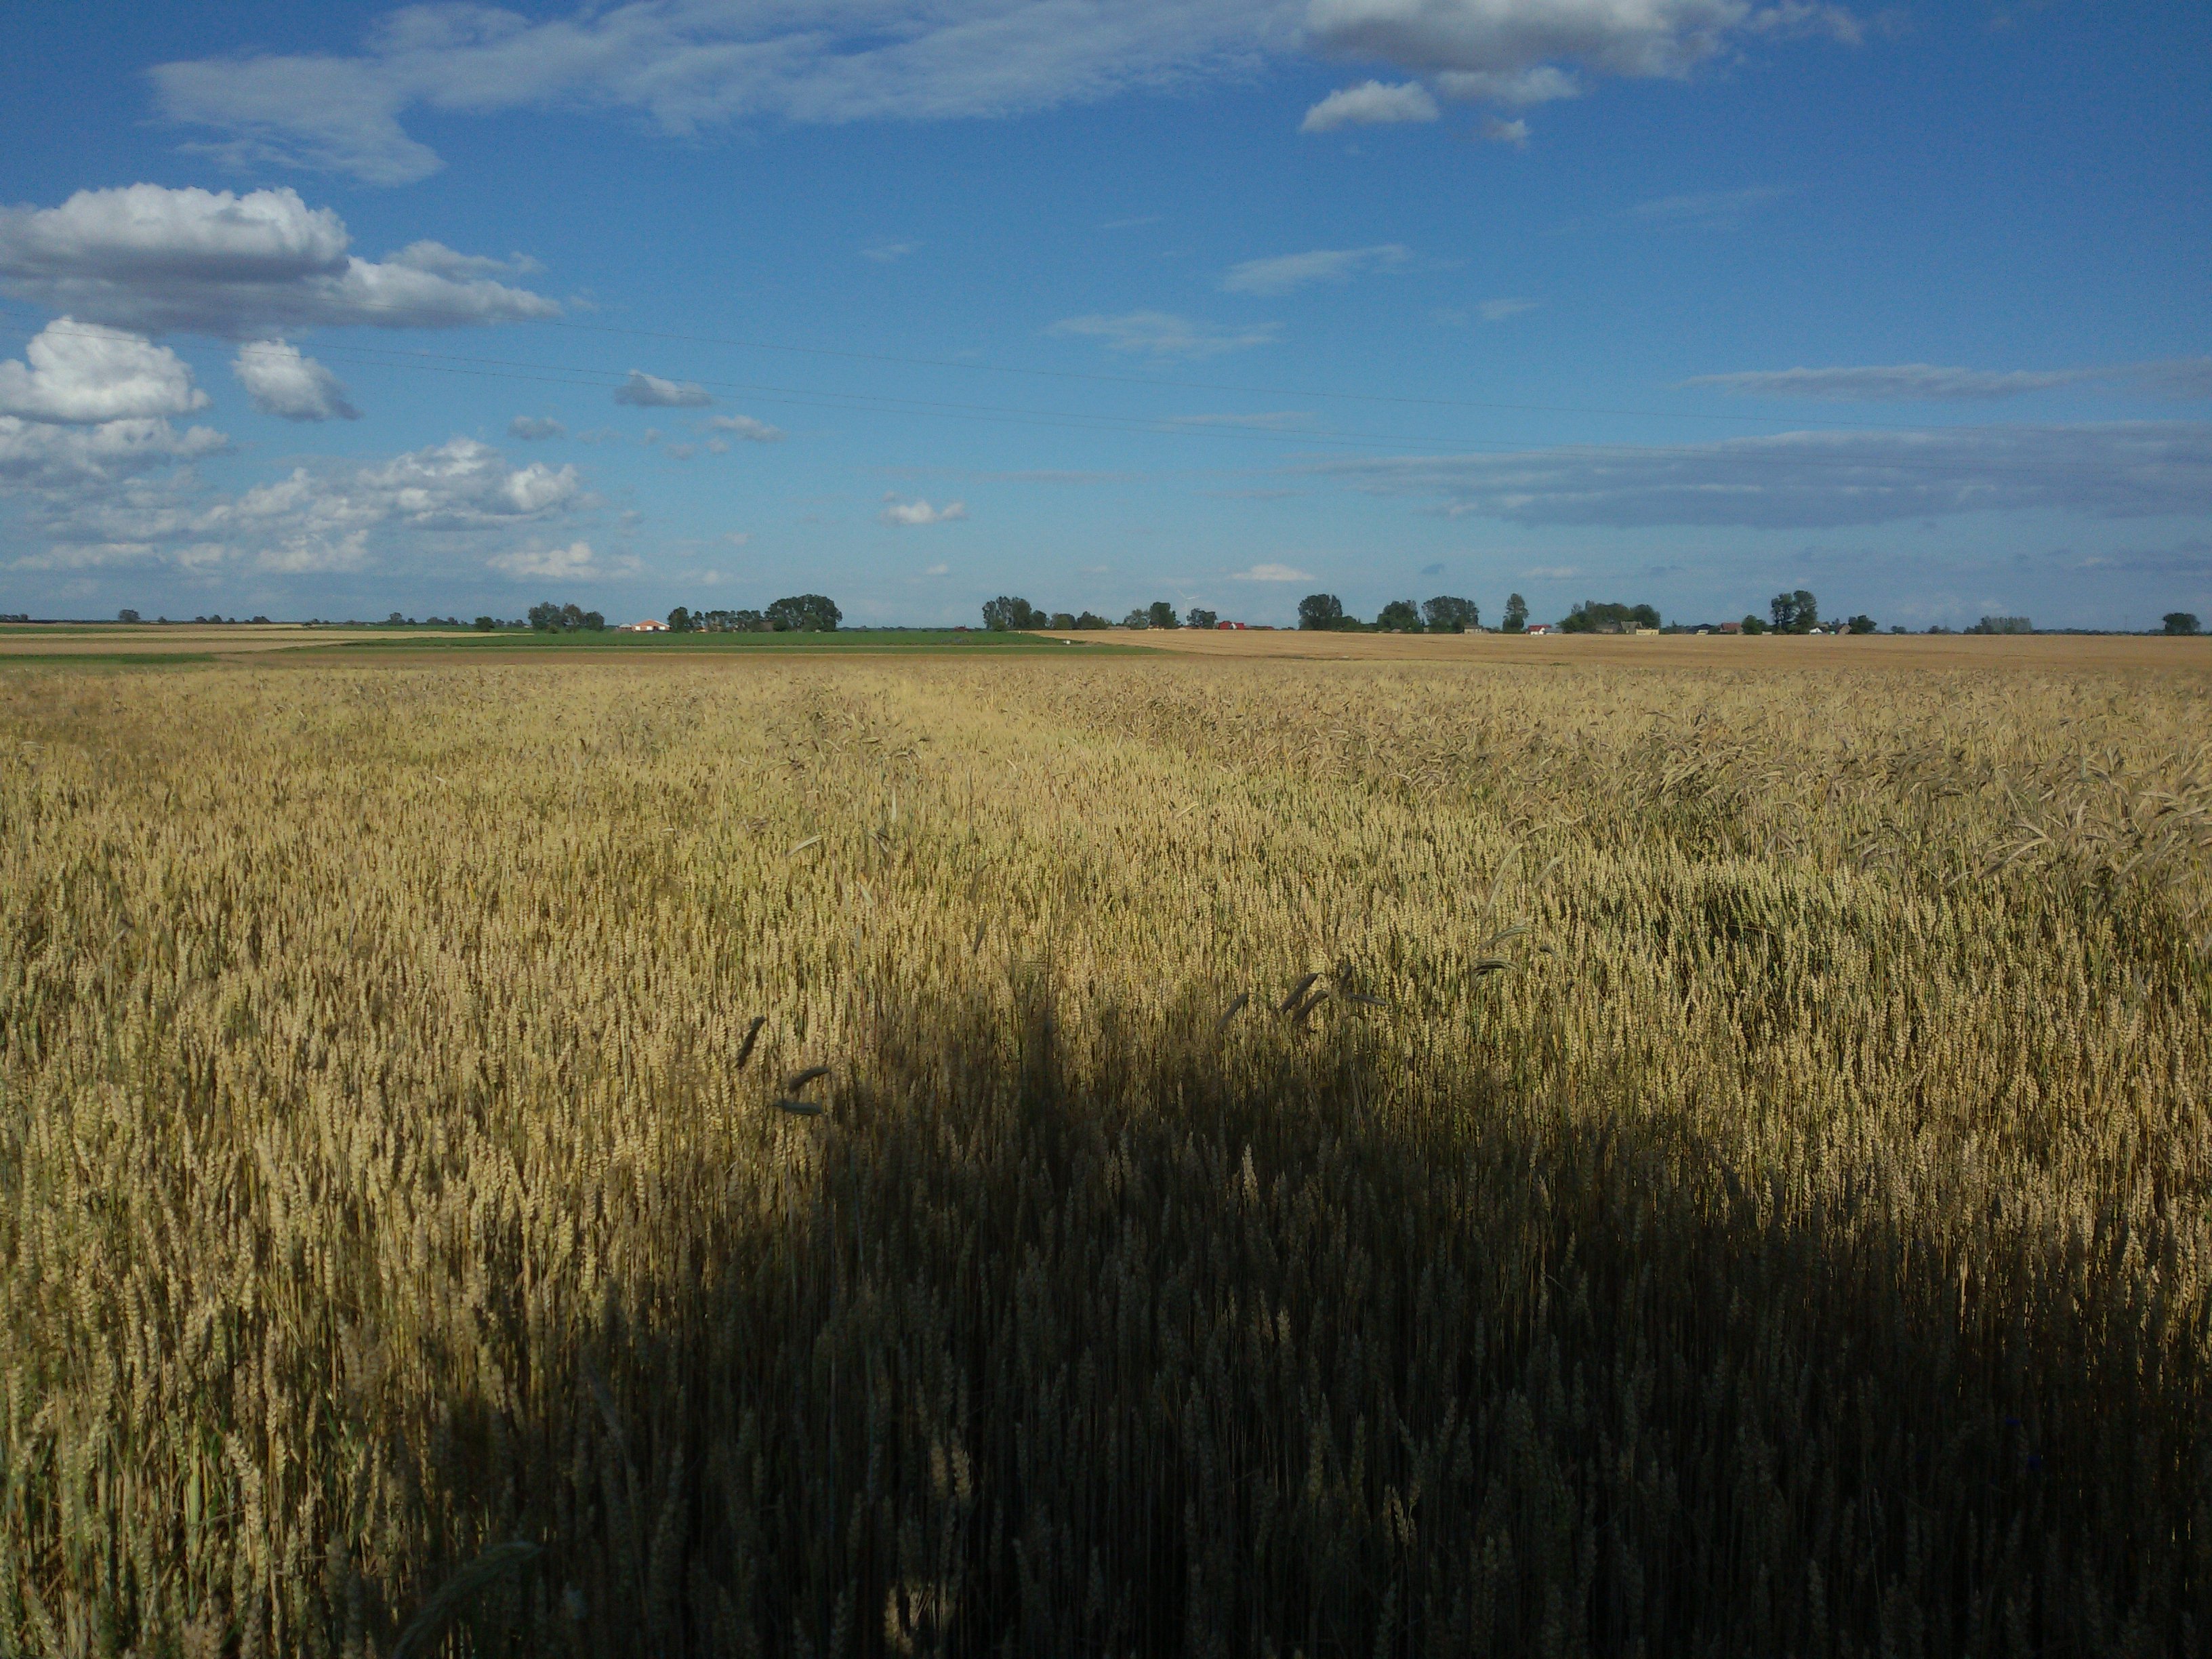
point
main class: Cropland
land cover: Common wheat
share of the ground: > 75 %
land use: Agriculture (excluding fallow land and kitchen gardens)
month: July
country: PL
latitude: 52.6256
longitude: 17.5320
